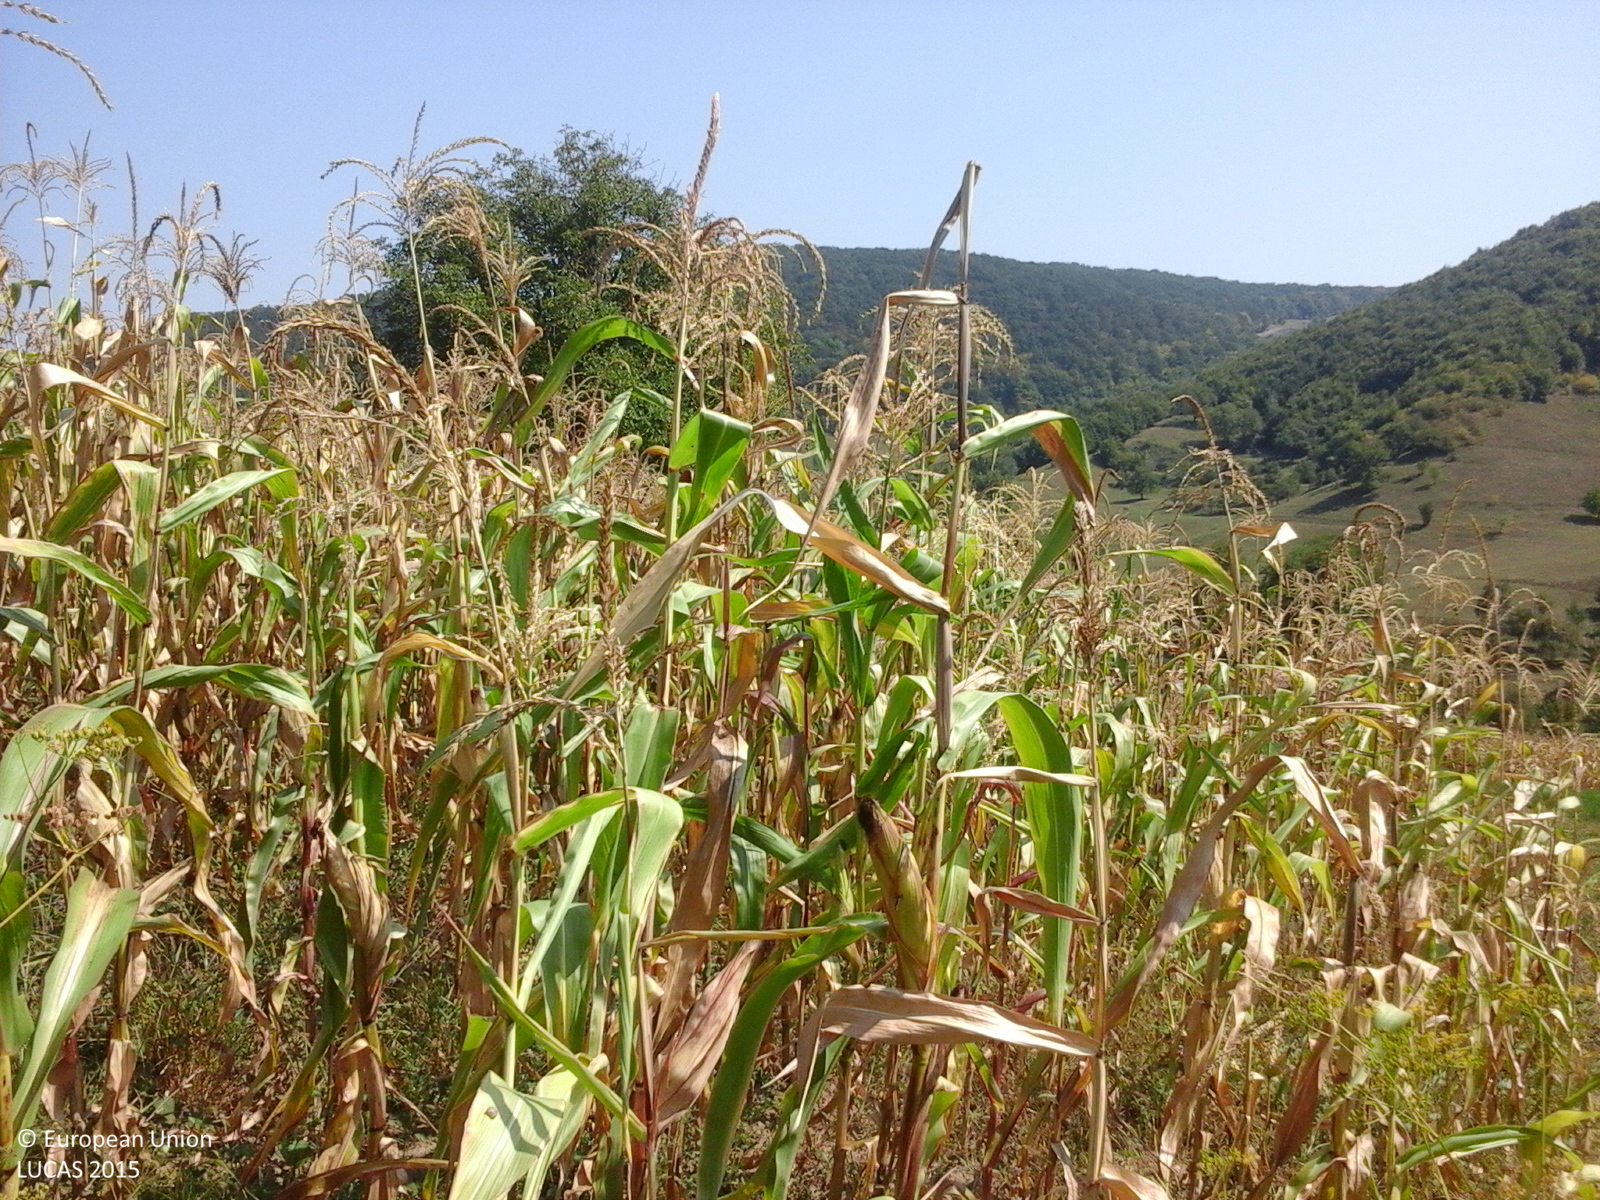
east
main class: Grassland
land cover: Spontaneously vegetated surfaces
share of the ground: > 75 %
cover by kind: herbaceous plants 100 %
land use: Fallow land
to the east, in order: Spontaneously vegetated surfaces; Maize; Lucerne; Single bushes/trees; Lucerne; Maize; Lucerne; Maize; Abandoned hedges; Artificial constructions in urban areas
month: September
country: RO
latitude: 47.0731
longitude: 24.1078
